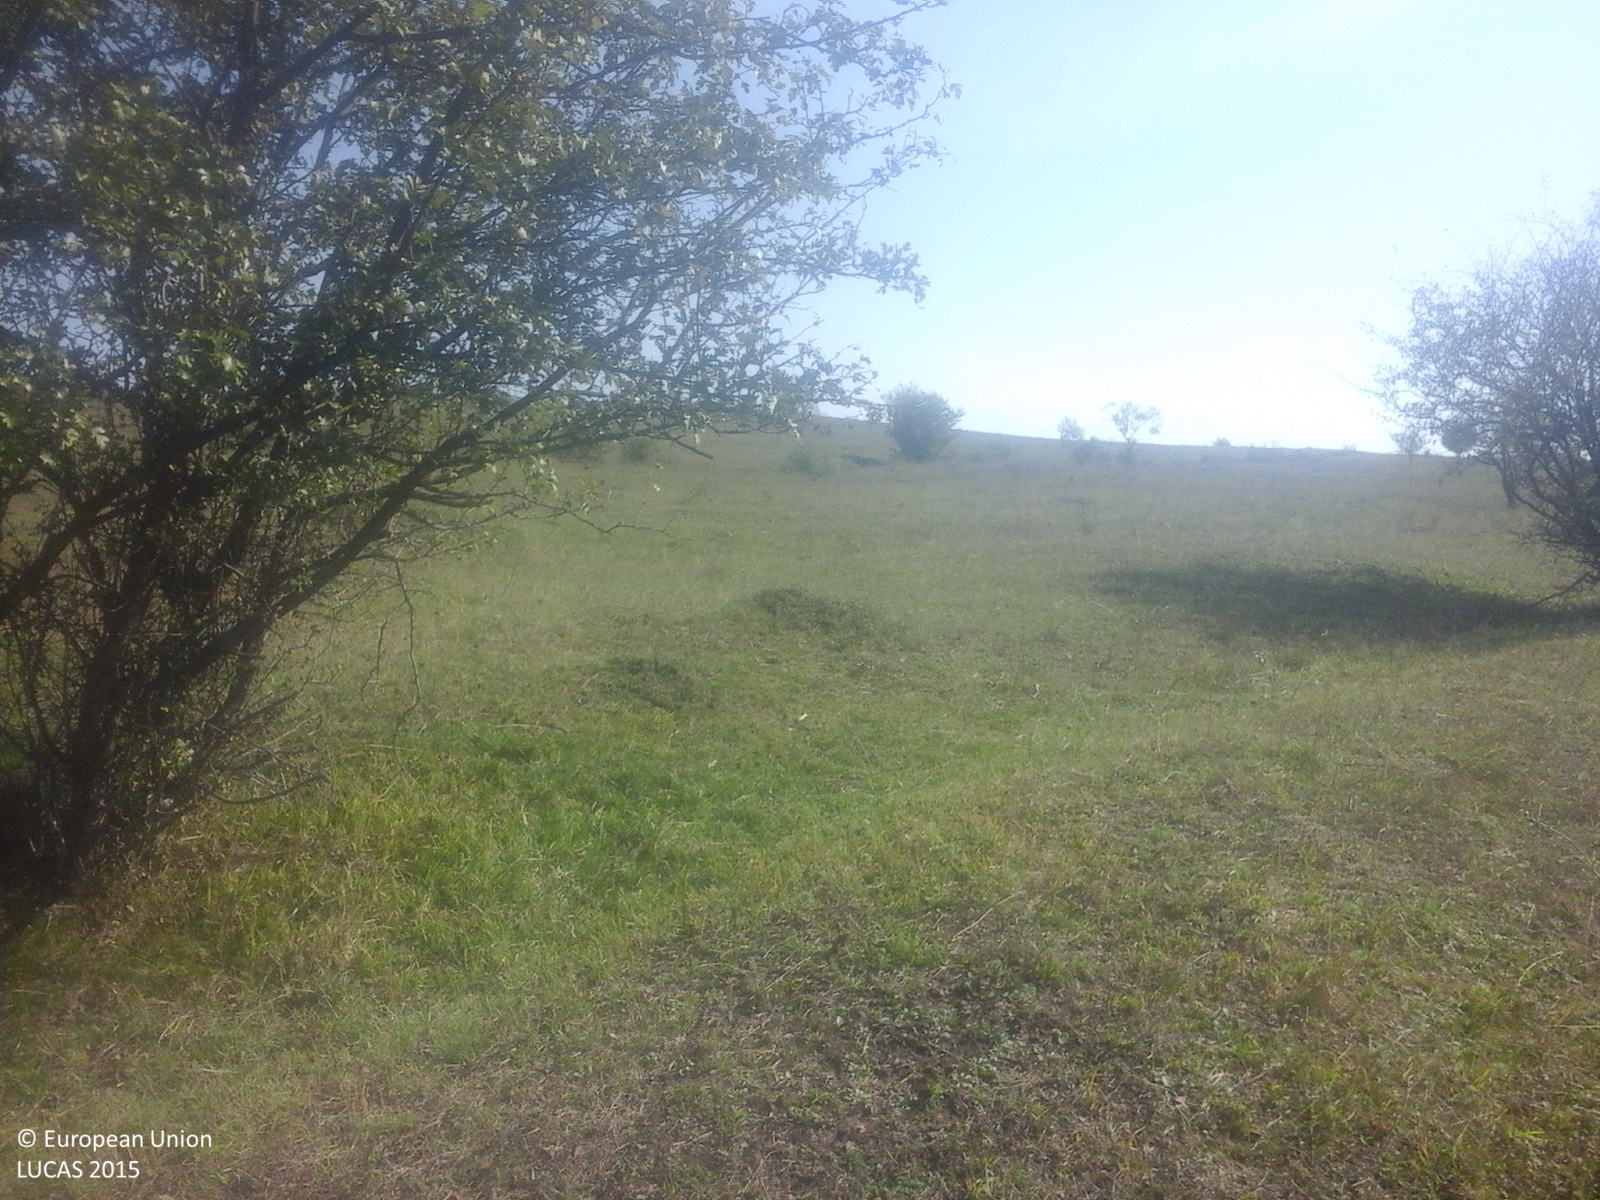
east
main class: Grassland
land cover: Grassland with sparse tree/shrub cover
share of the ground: > 75 %
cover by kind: herbaceous plants 85 %, shrubs 10 %, broadleaved forest trees 5 %
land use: Agriculture (excluding fallow land and kitchen gardens)
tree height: > 5 m
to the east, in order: Grassland with sparse tree/shrub cover; Grassland without tree/shrub cover; Abandoned hedges; Grassland without tree/shrub cover; Abandoned hedges; Grassland without tree/shrub cover; Spontaneously vegetated surfaces; Grassland without tree/shrub cover; Tracks; Grassland without tree/shrub cover
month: October
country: RO
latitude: 46.0110
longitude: 23.8511
